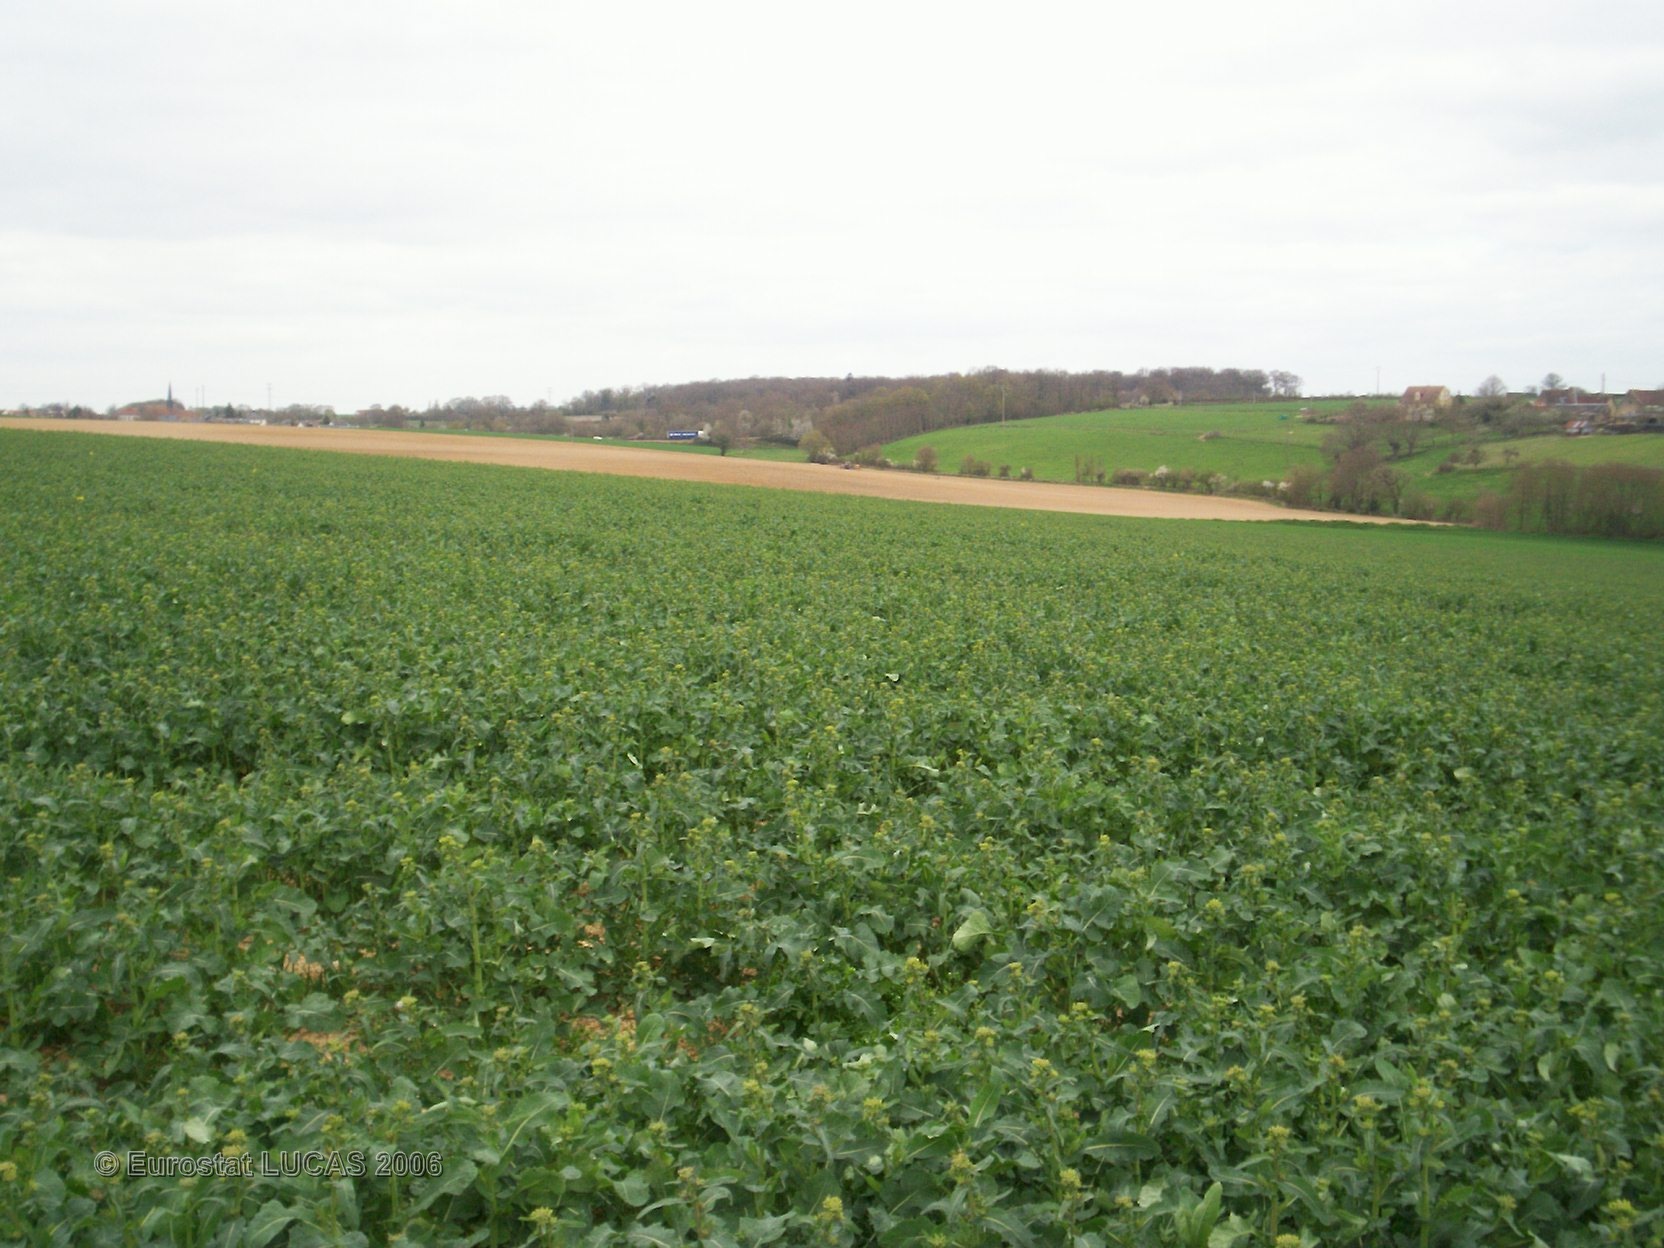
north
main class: Cropland
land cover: Rape and turnip rape
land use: Agriculture (excluding fallow land and kitchen gardens)
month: April
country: FR
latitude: 47.9096
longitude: 0.7879
